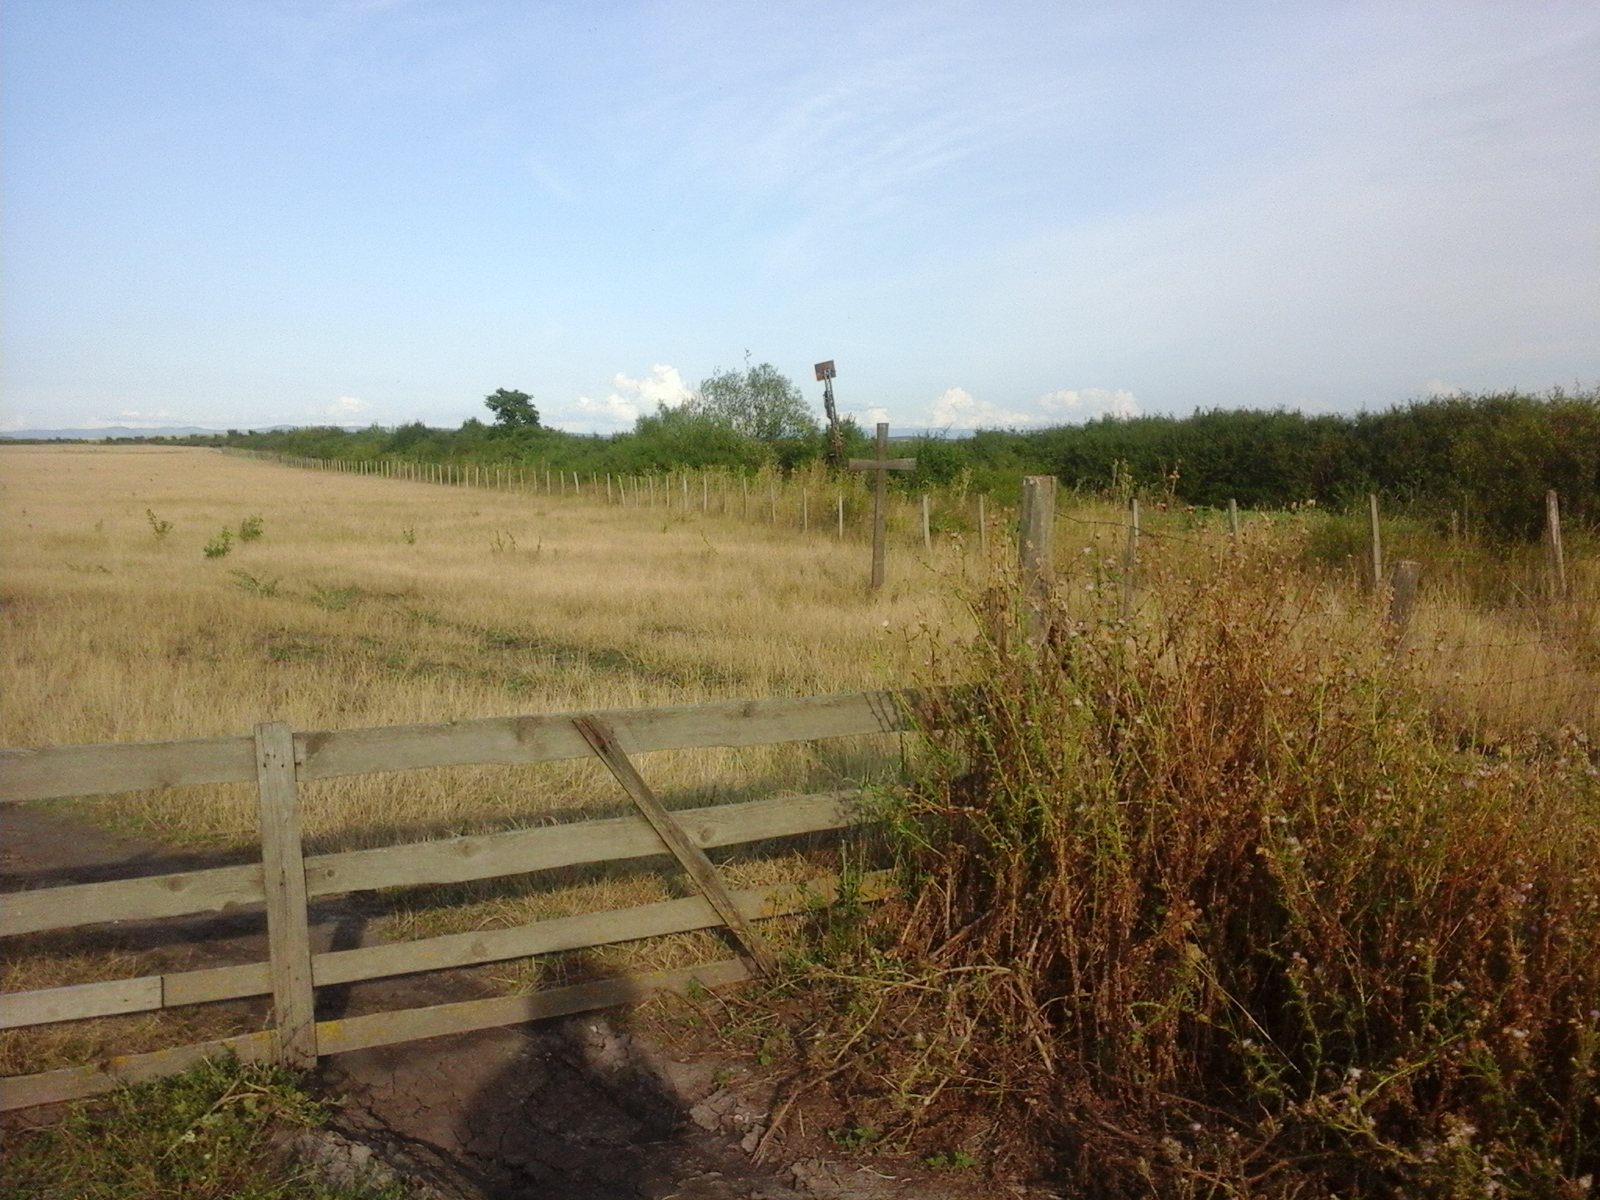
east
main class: Grassland
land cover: Grassland without tree/shrub cover
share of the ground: > 75 %
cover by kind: herbaceous plants 100 %
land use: Agriculture (excluding fallow land and kitchen gardens)
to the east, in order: Grassland without tree/shrub cover; Fences; Grassland without tree/shrub cover
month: August
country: RO
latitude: 45.2655
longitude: 21.4110
